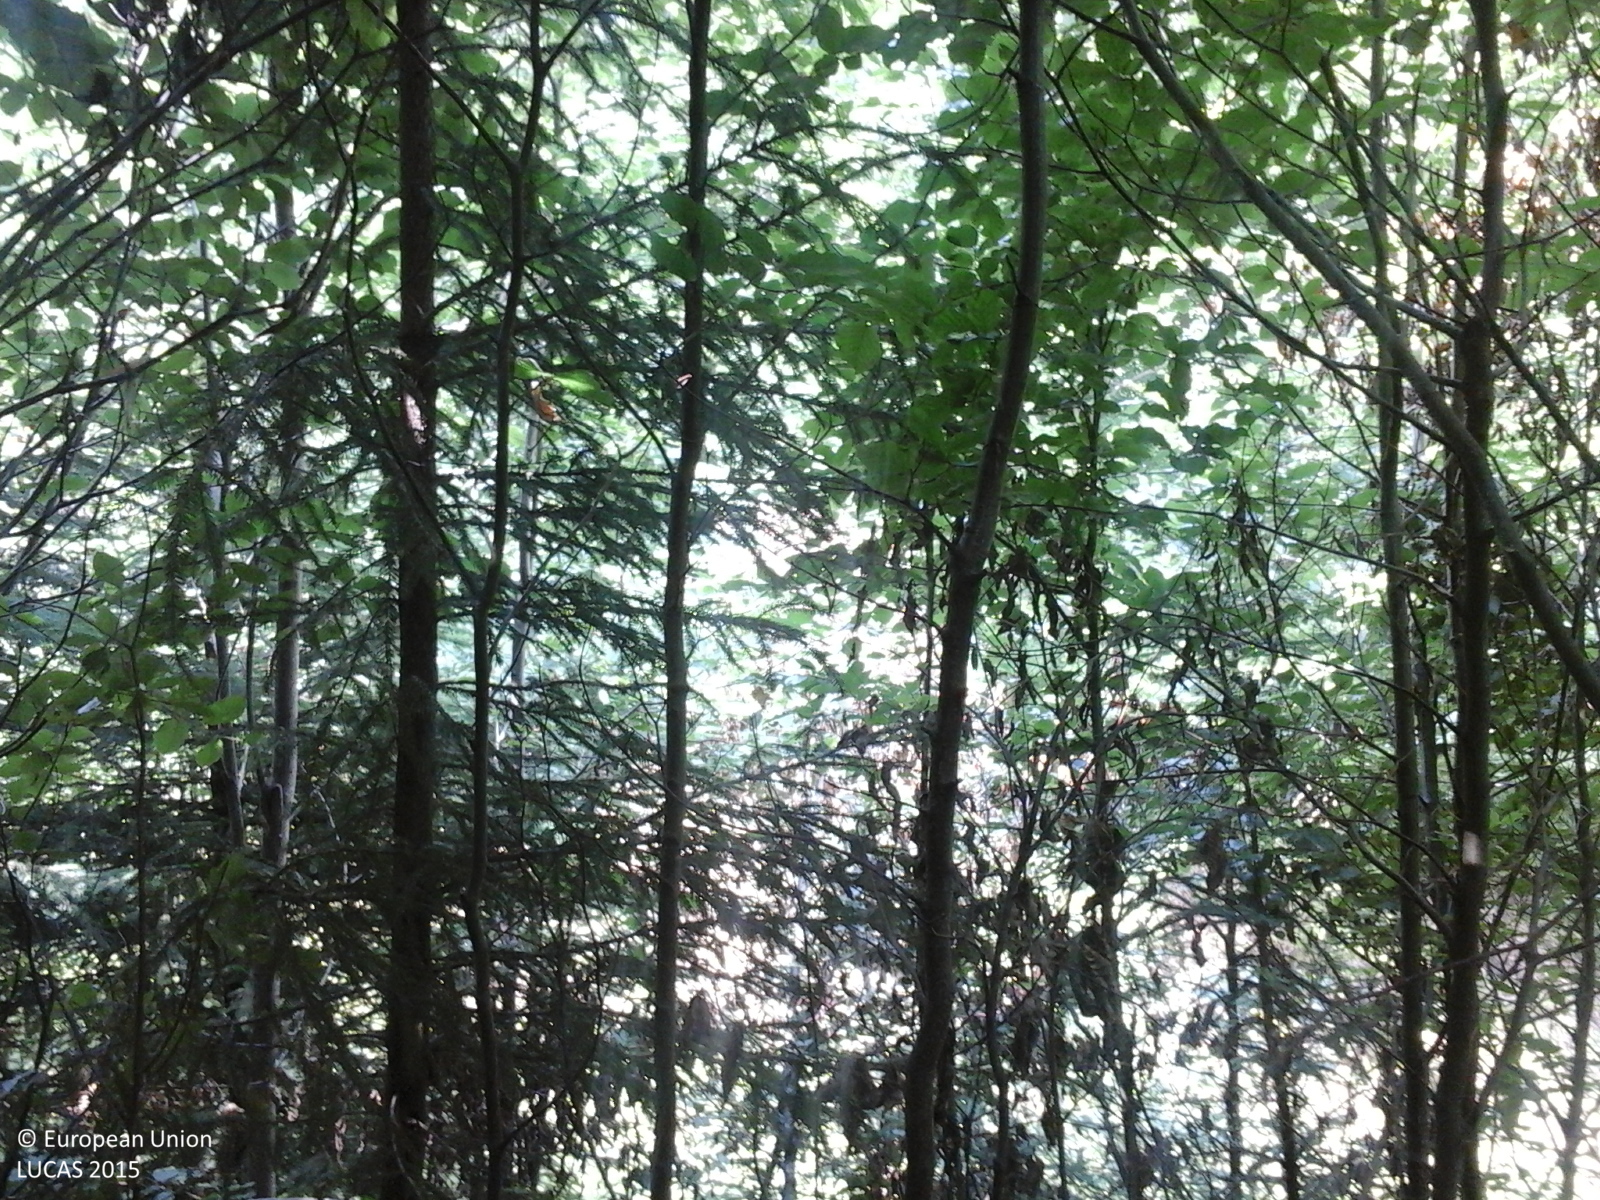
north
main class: Woodland
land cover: Other mixed woodland
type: beech forest
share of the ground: > 75 %
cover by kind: broadleaved forest trees 75 %, coniferous forest trees 25 %
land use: Forestry
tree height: > 5 m
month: July
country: RO
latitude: 45.3828
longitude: 24.5753
